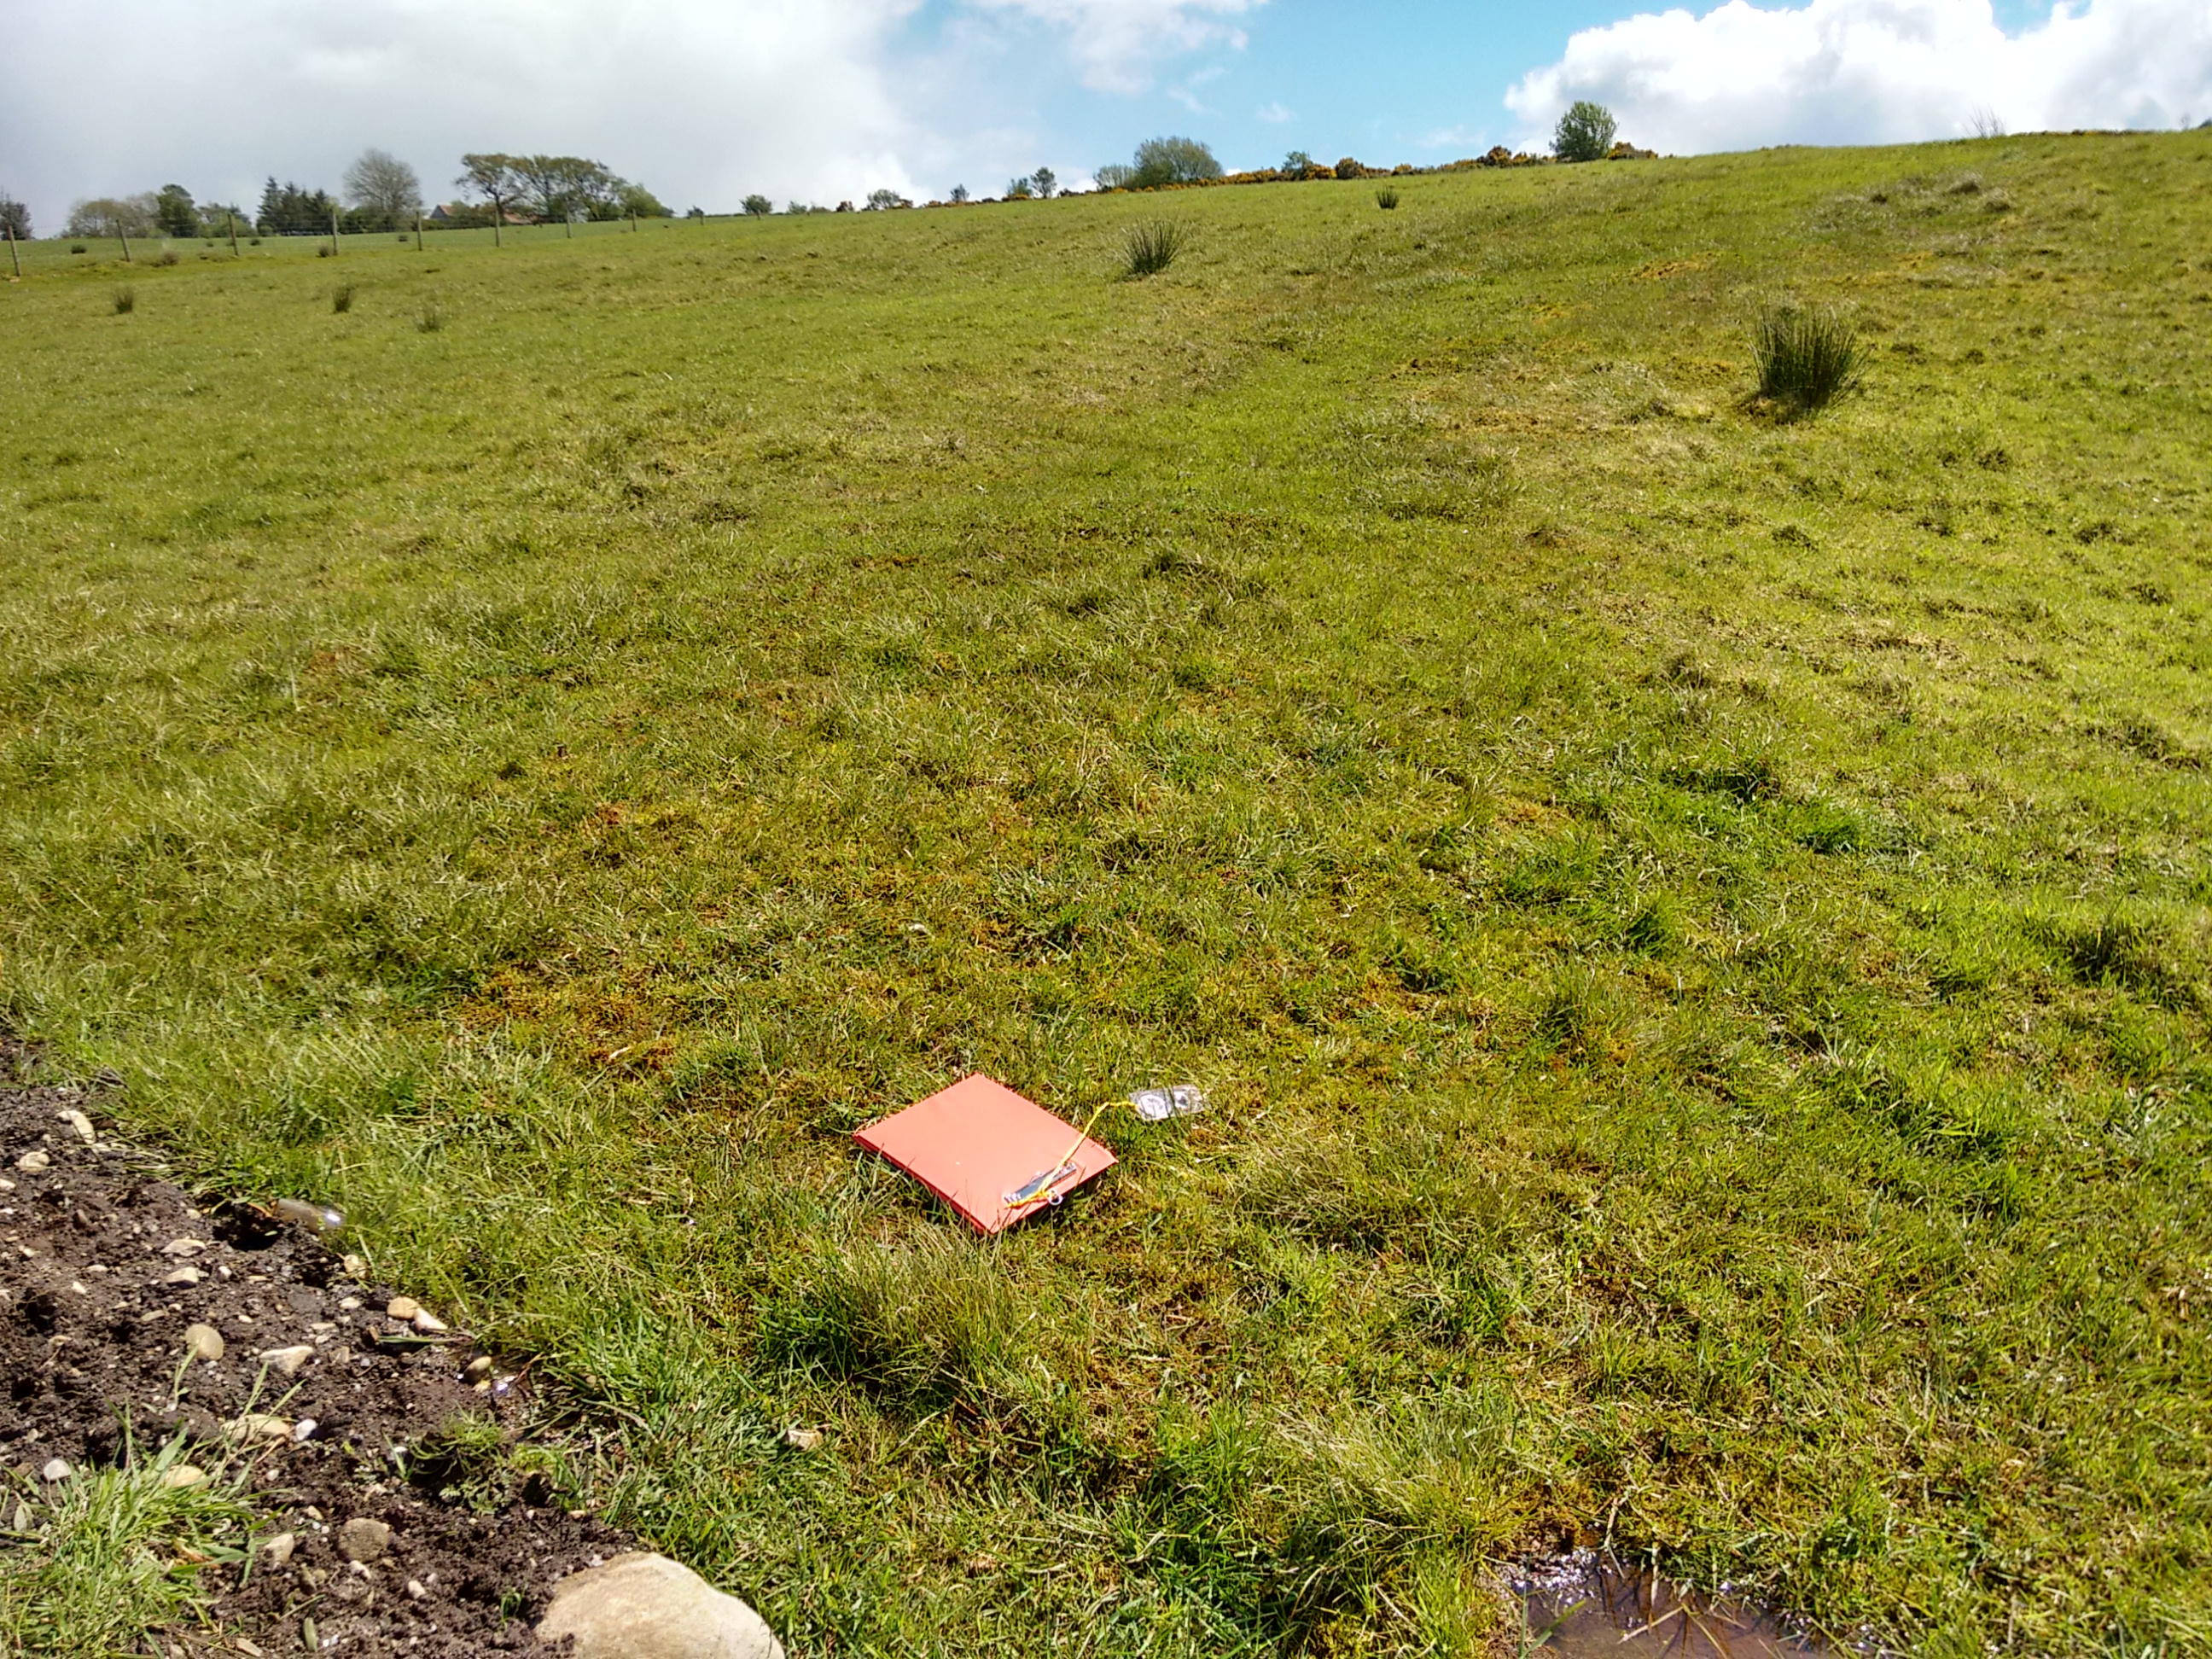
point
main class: Grassland
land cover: Grassland without tree/shrub cover
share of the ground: > 75 %
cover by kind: herbaceous plants 100 %
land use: Agriculture (excluding fallow land and kitchen gardens)
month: May
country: GB
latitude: 54.9246
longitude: -7.0382
